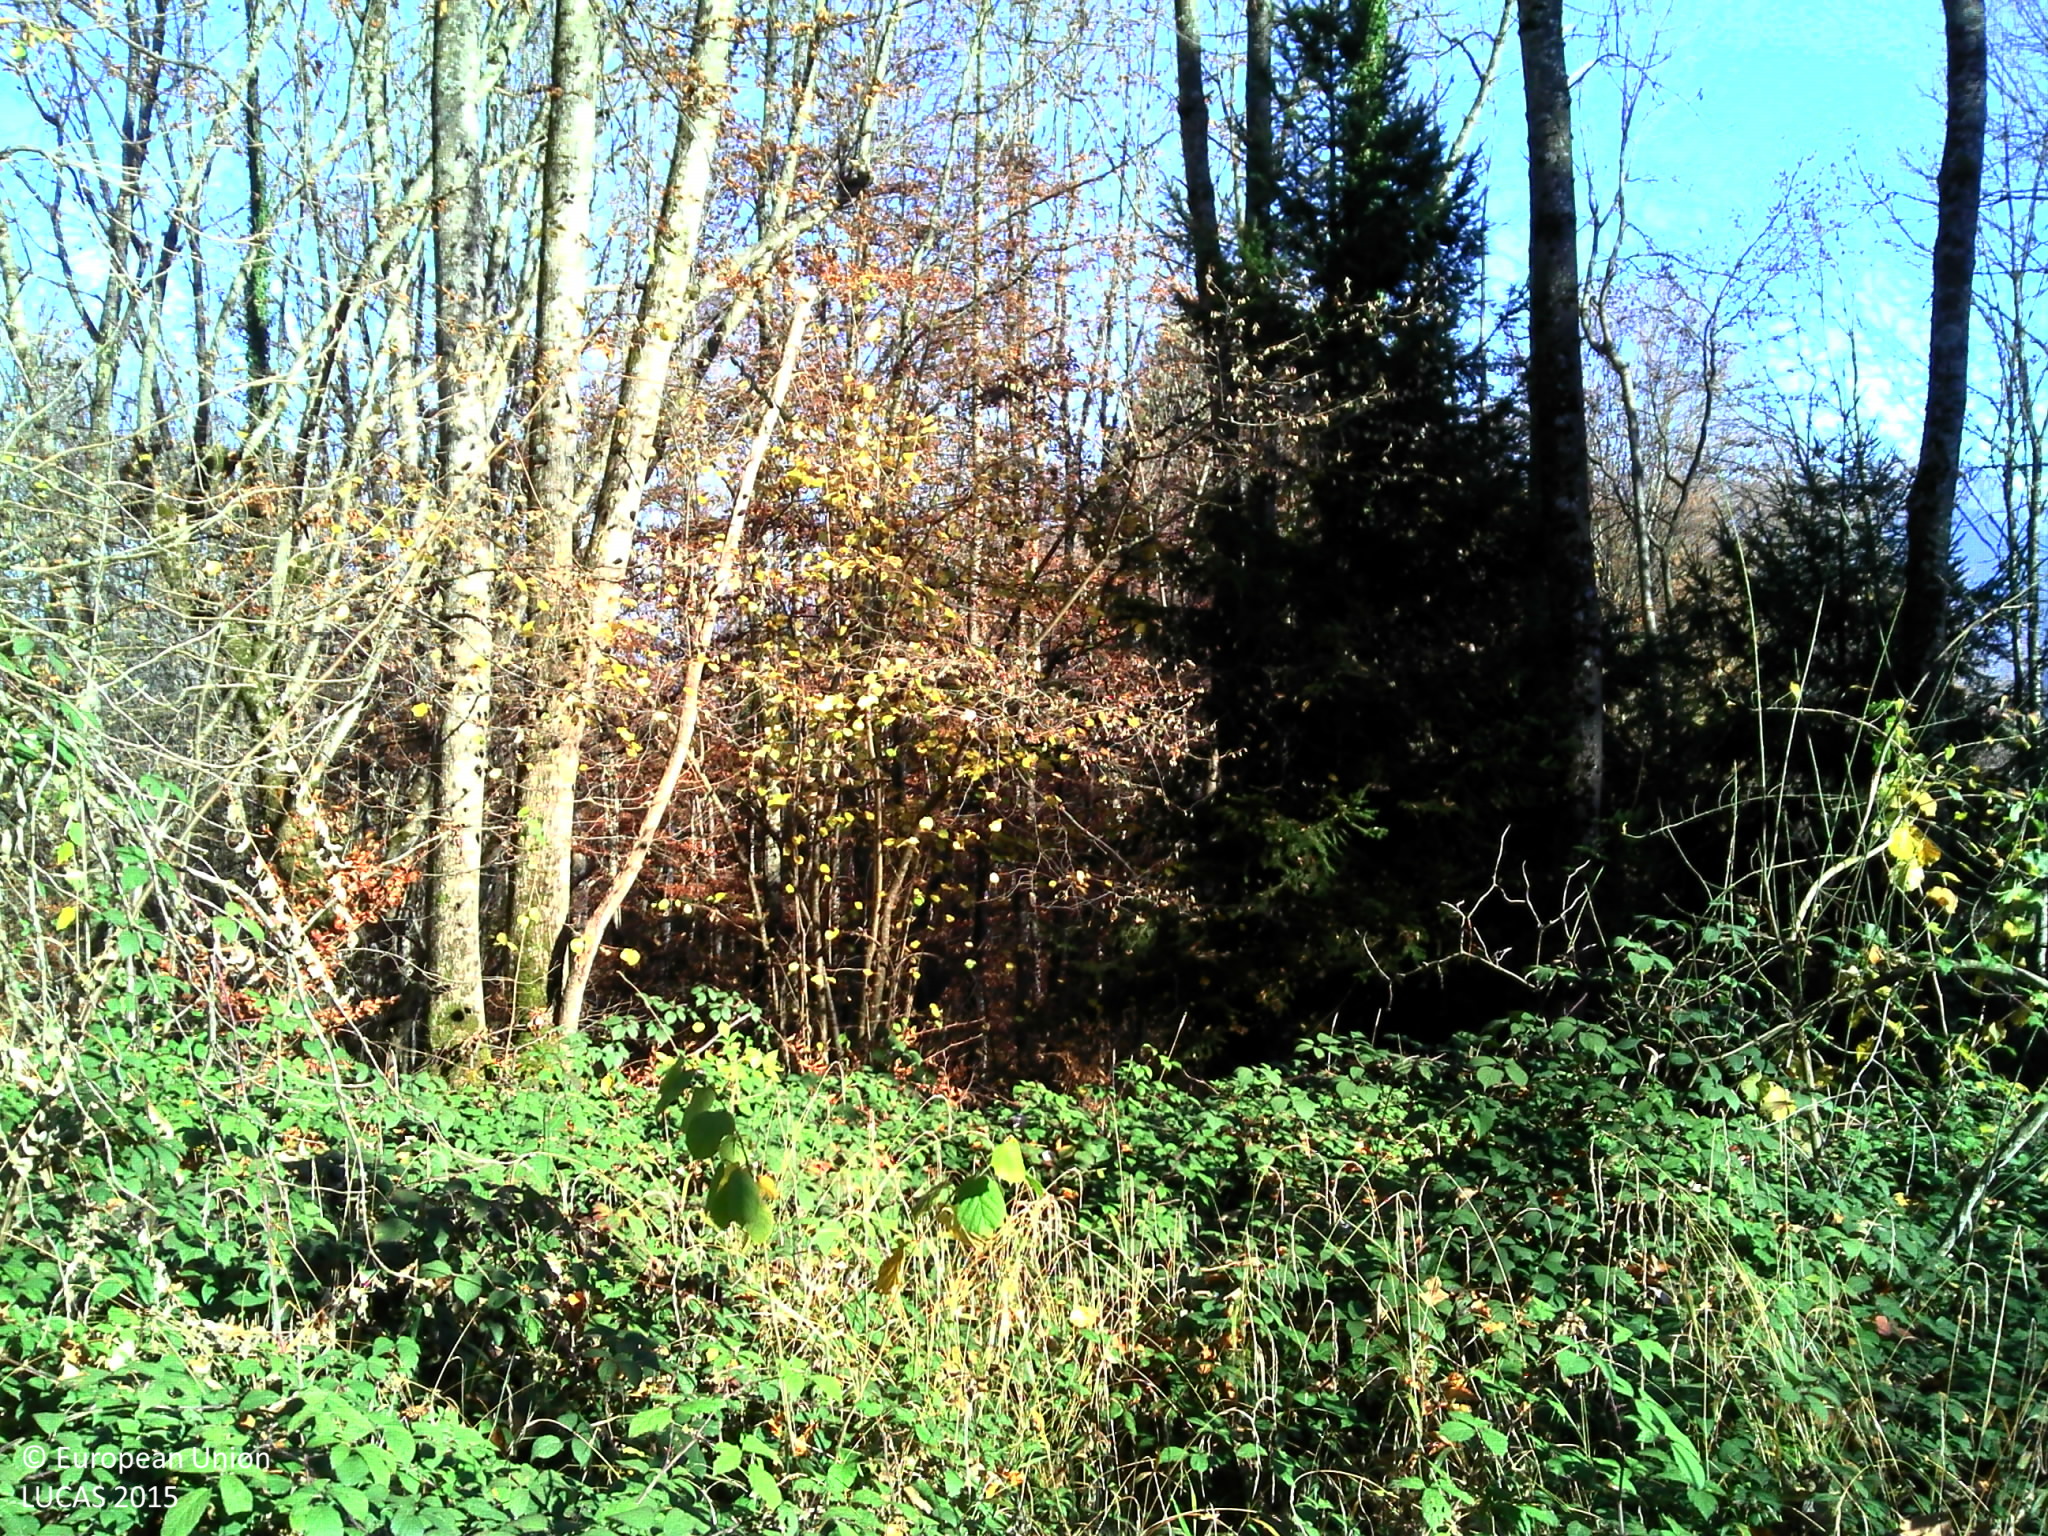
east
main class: Woodland
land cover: Broadleaved woodland
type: mesophytic deciduous forest
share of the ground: 50 - 75 %
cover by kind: broadleaved forest trees 45 %, shrubs 45 %, herbaceous plants 10 %
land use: Forestry
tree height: > 5 m
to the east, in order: Broadleaved woodland; Tracks; Broadleaved woodland; Tracks; Broadleaved woodland
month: November
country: FR
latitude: 45.6748
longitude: 6.3200
